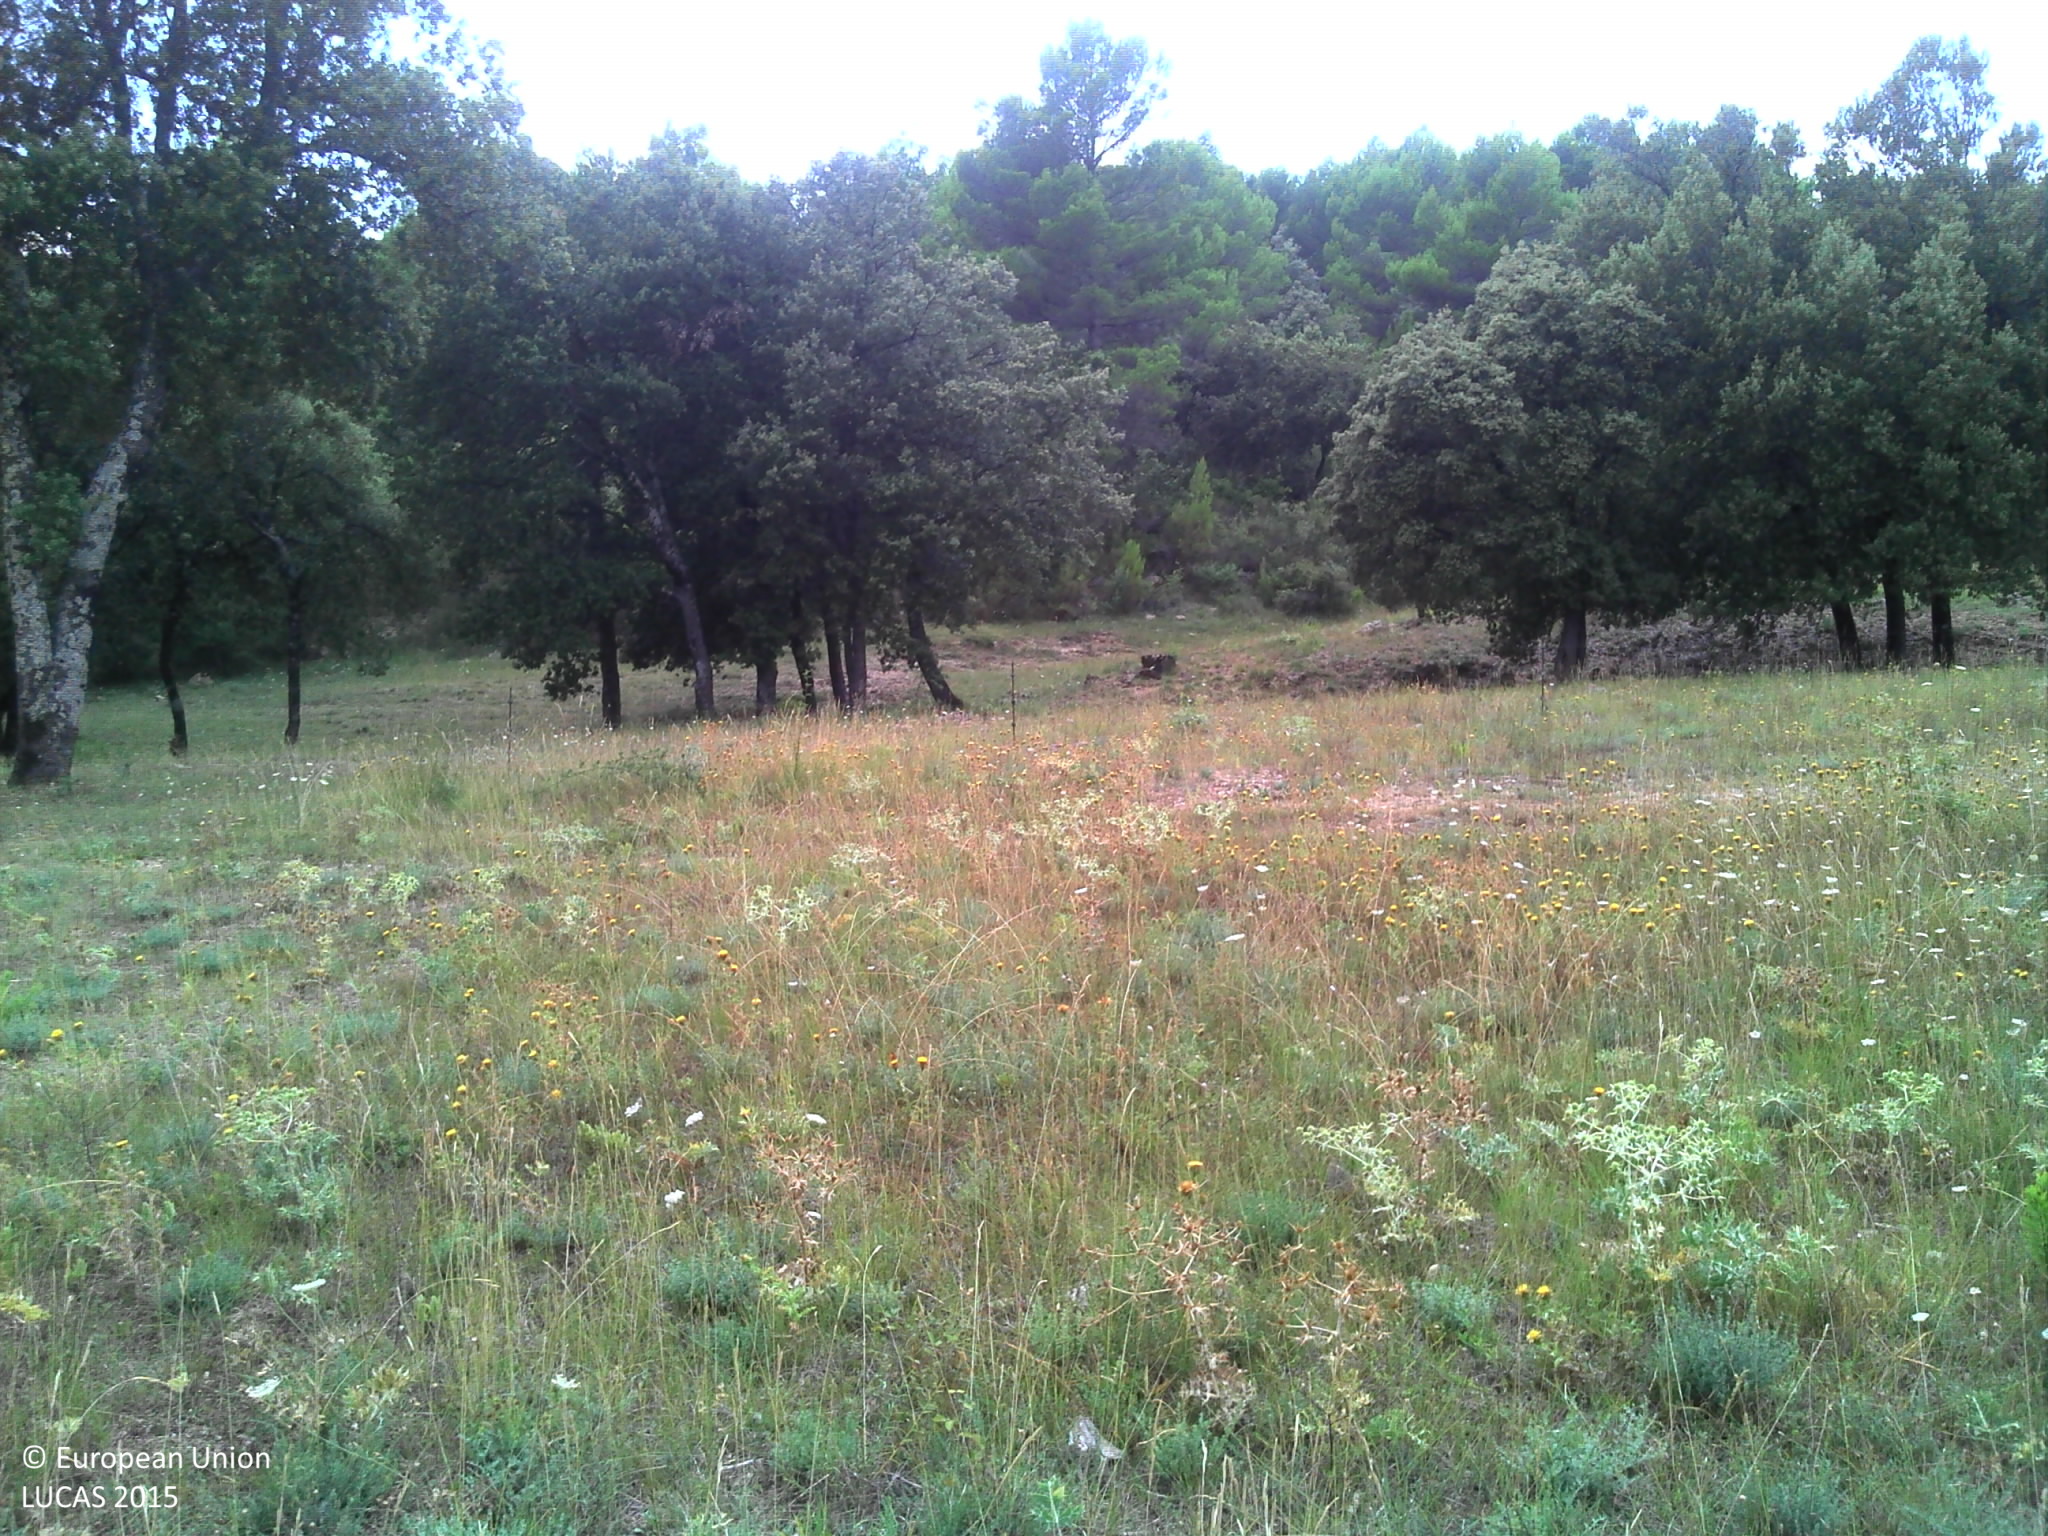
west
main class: Grassland
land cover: Grassland with sparse tree/shrub cover
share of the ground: > 75 %
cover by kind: herbaceous plants 95 %, coniferous forest trees 5 %
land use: Amenities, museums, leisure
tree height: > 5 m
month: August
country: FR
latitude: 43.5814
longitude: 6.3305
